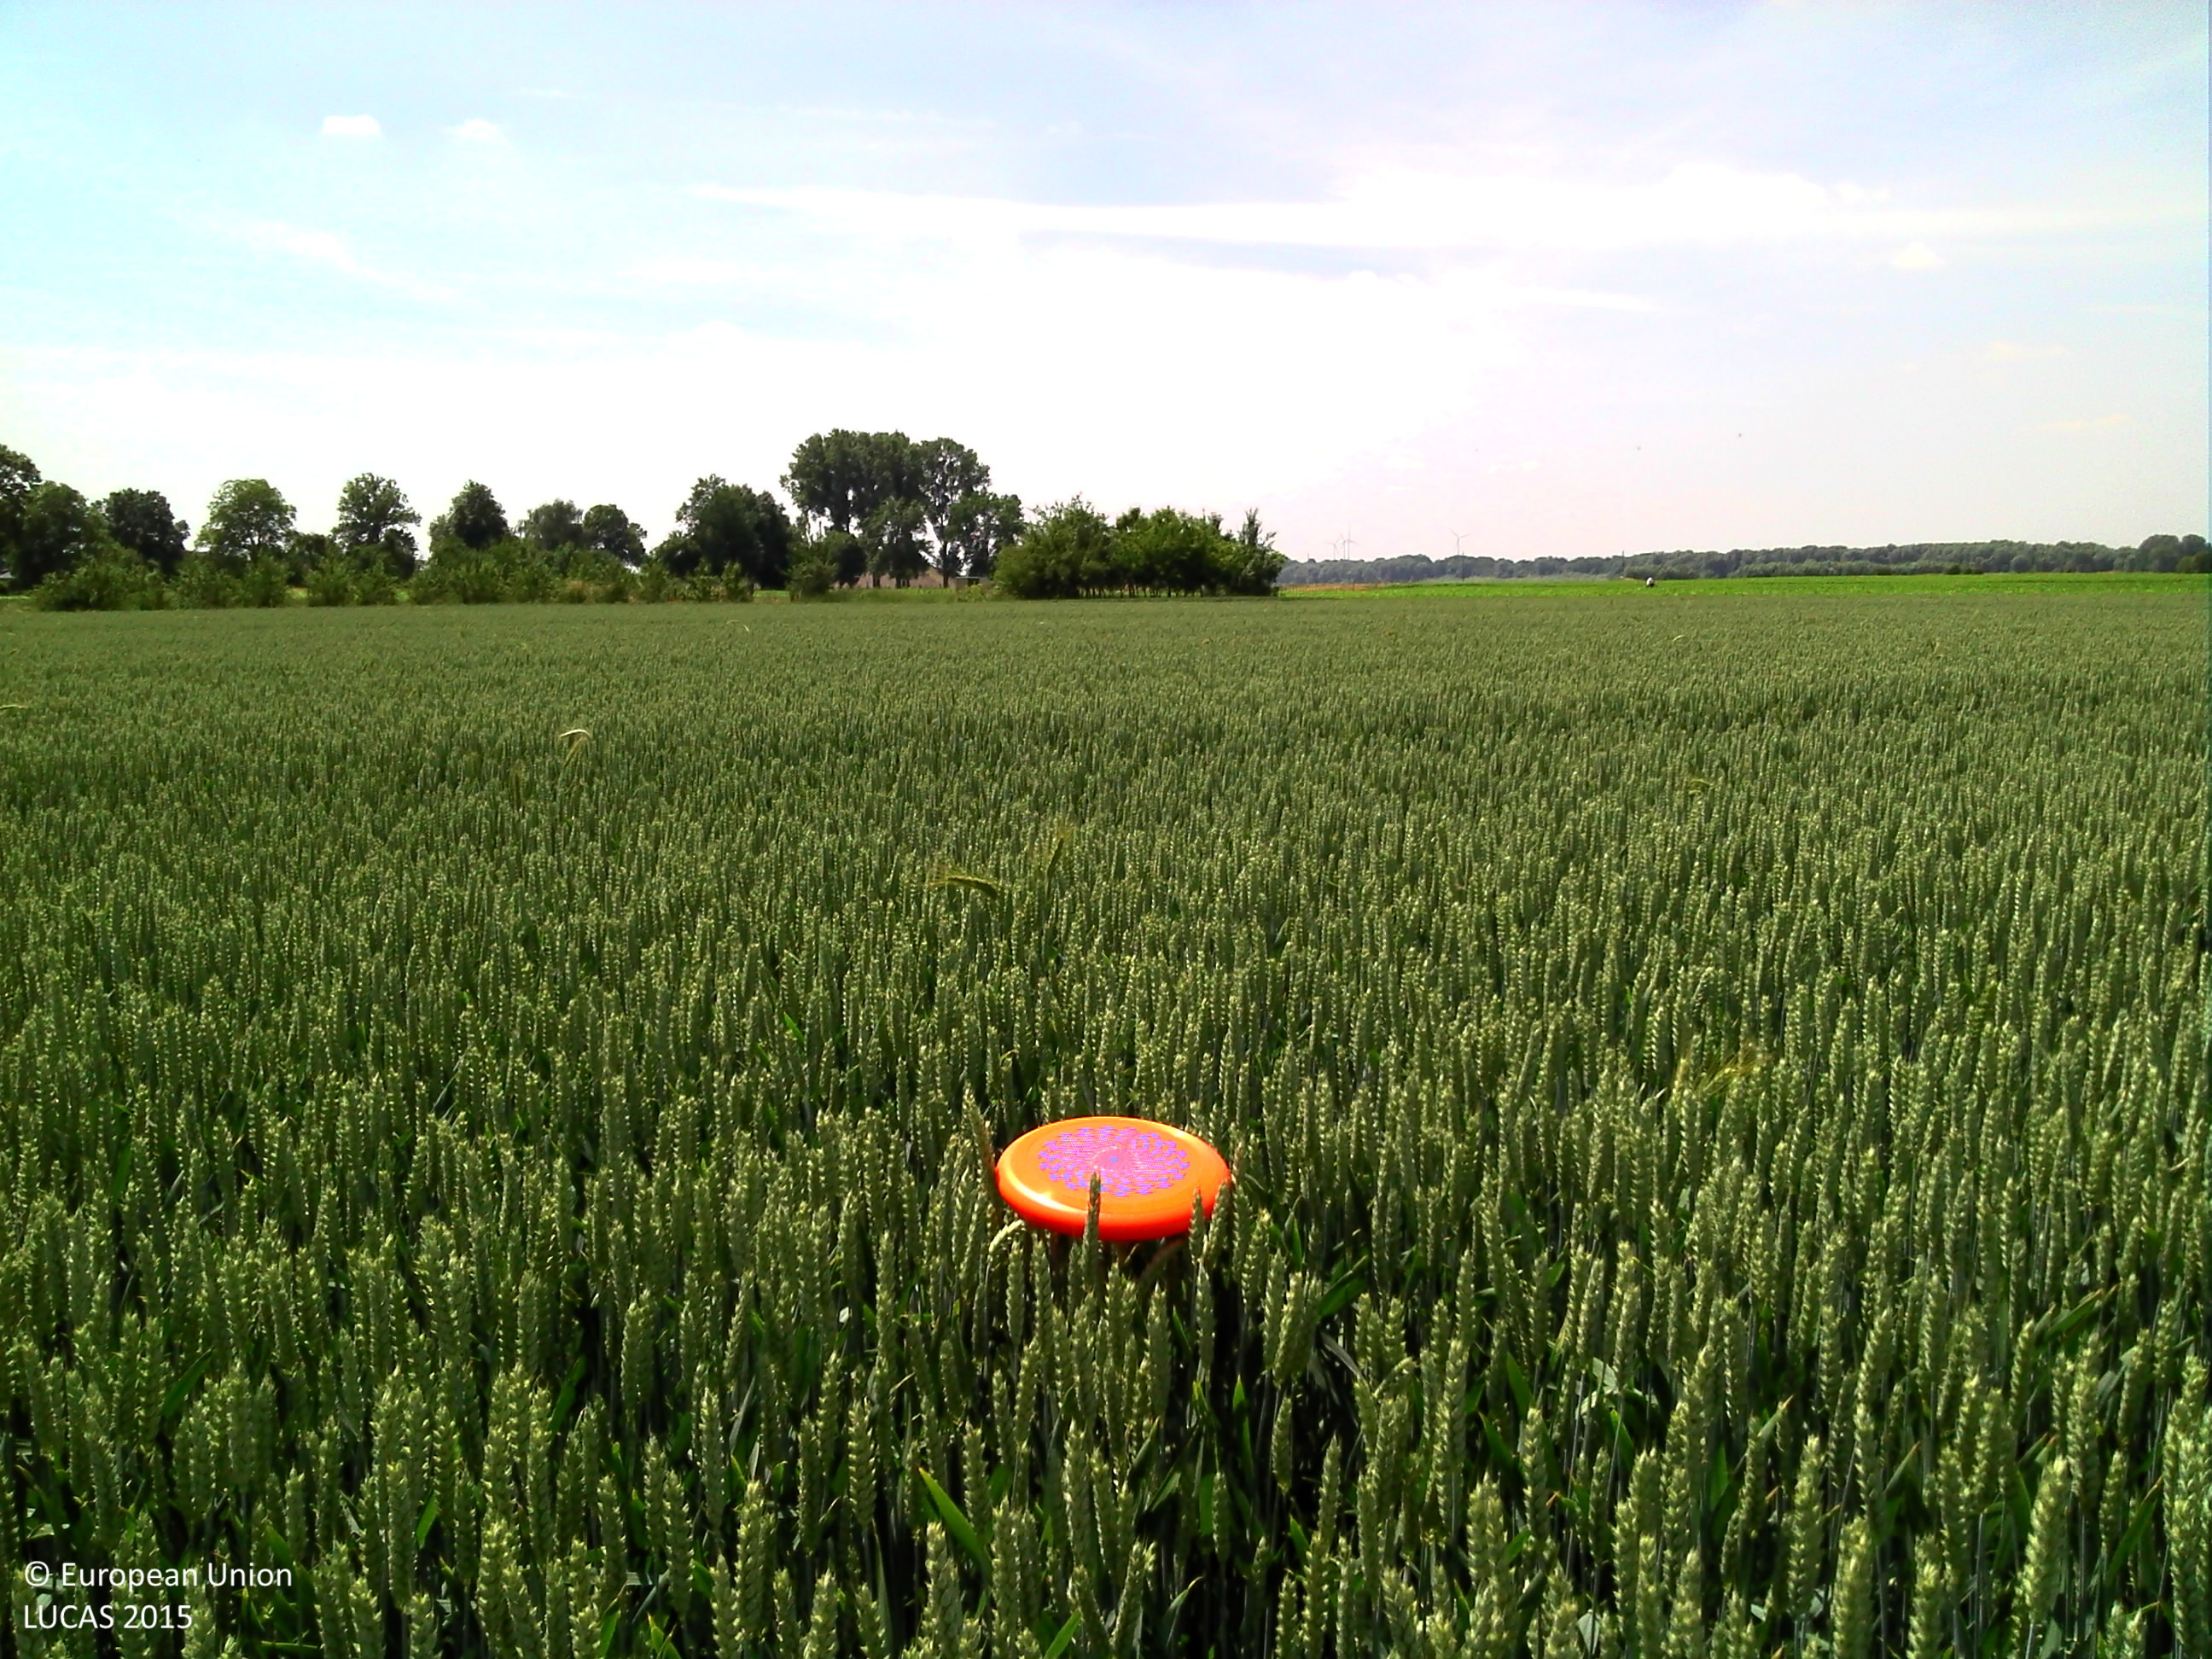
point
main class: Cropland
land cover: Common wheat
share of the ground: > 75 %
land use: Agriculture (excluding fallow land and kitchen gardens)
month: June
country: BE
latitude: 50.9141
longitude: 5.7173
